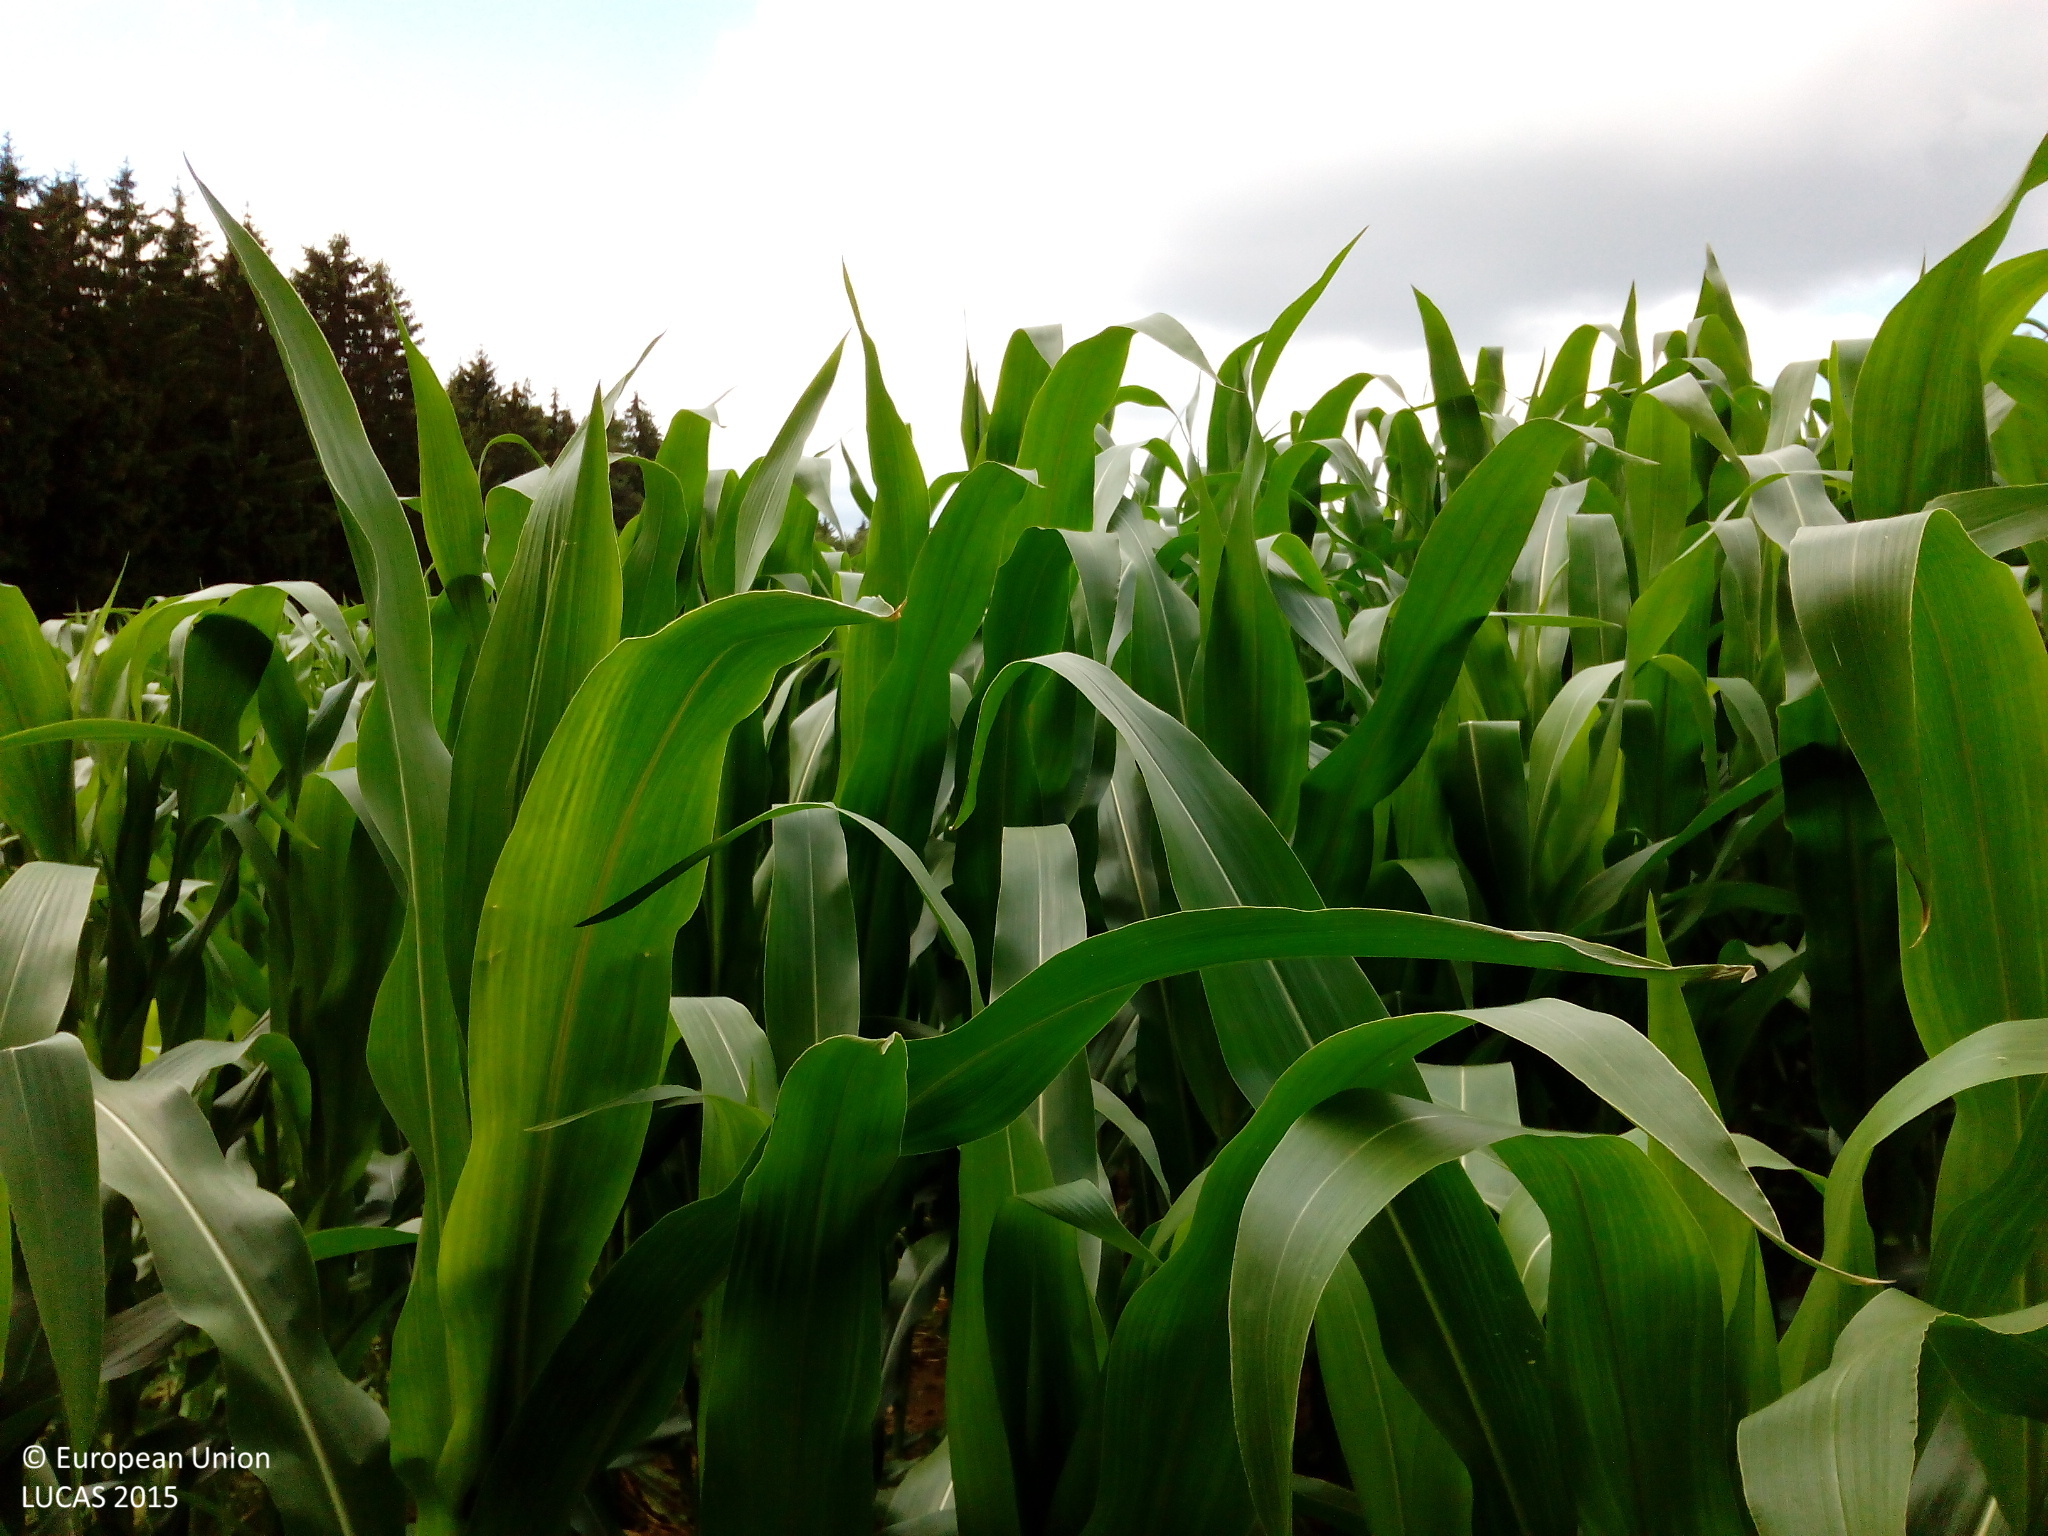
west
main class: Cropland
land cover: Maize
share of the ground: > 75 %
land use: Agriculture (excluding fallow land and kitchen gardens)
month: July
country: DE
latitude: 49.8345
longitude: 12.4327
